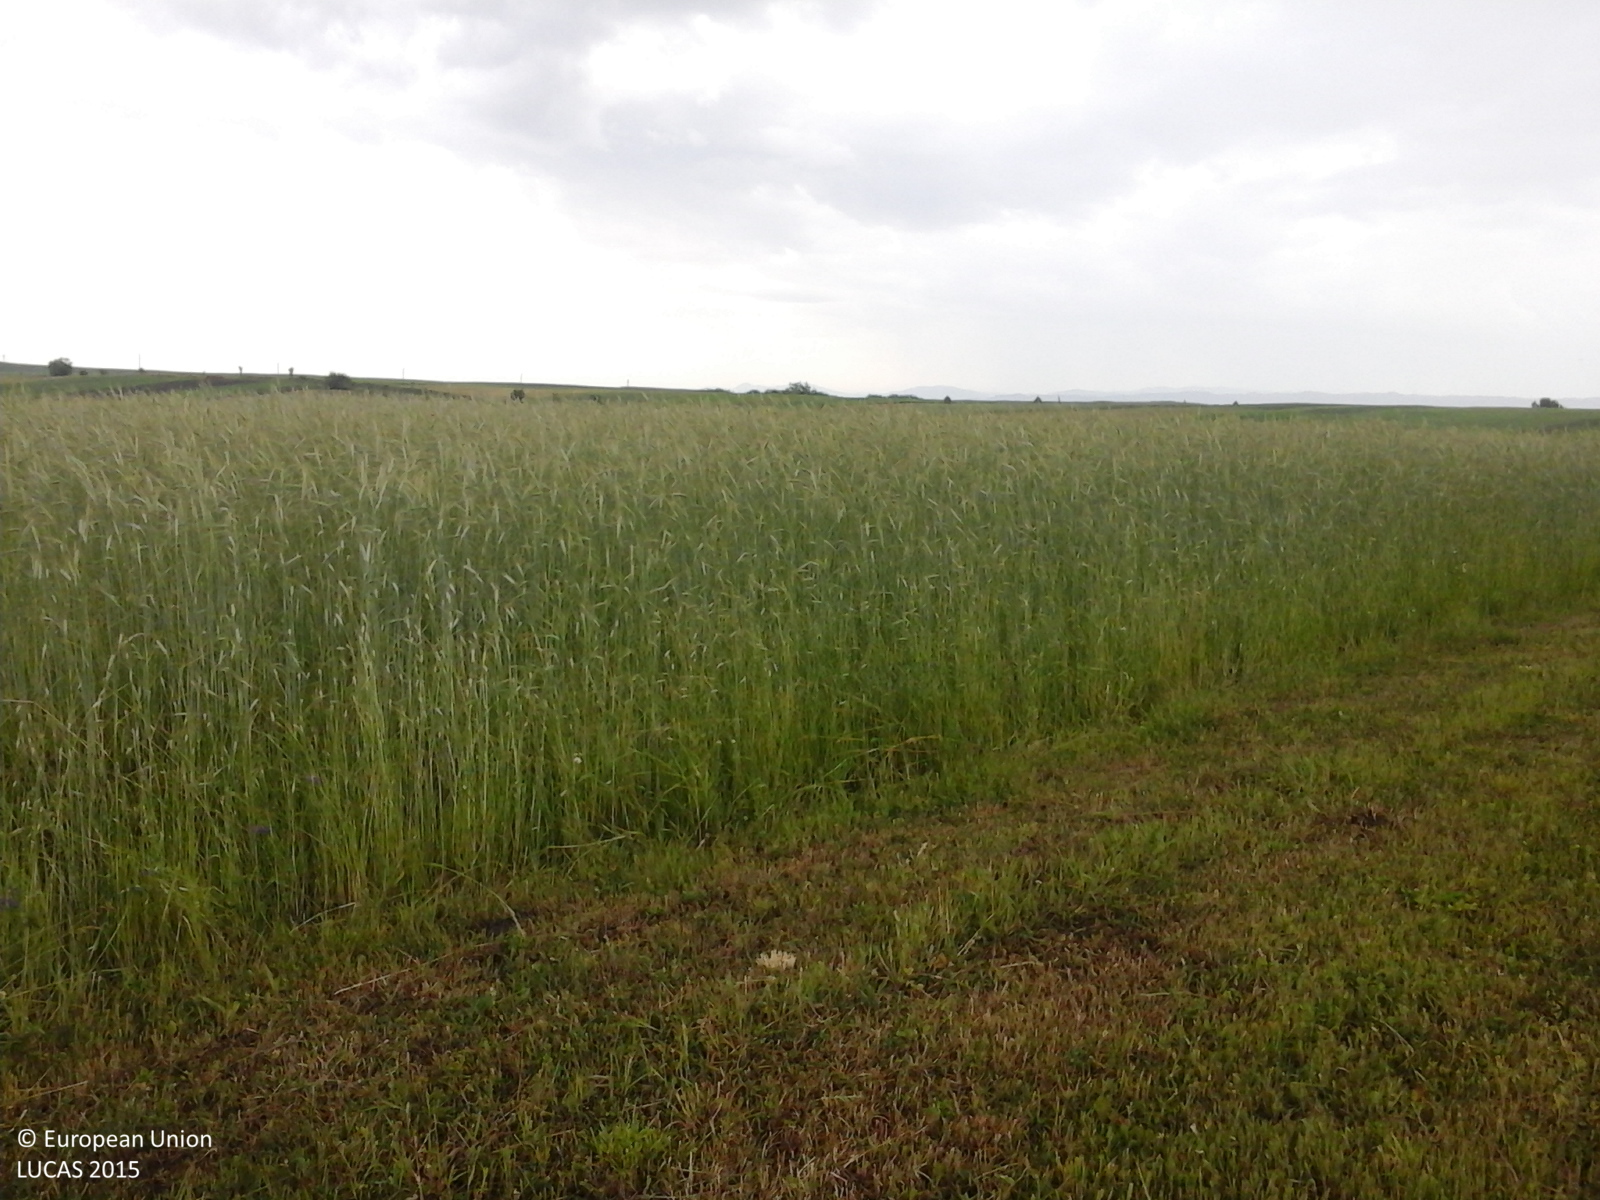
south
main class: Cropland
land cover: Other leguminous and mixtures for fodder
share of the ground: > 75 %
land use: Agriculture (excluding fallow land and kitchen gardens)
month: June
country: RO
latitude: 47.4067
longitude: 26.3985
